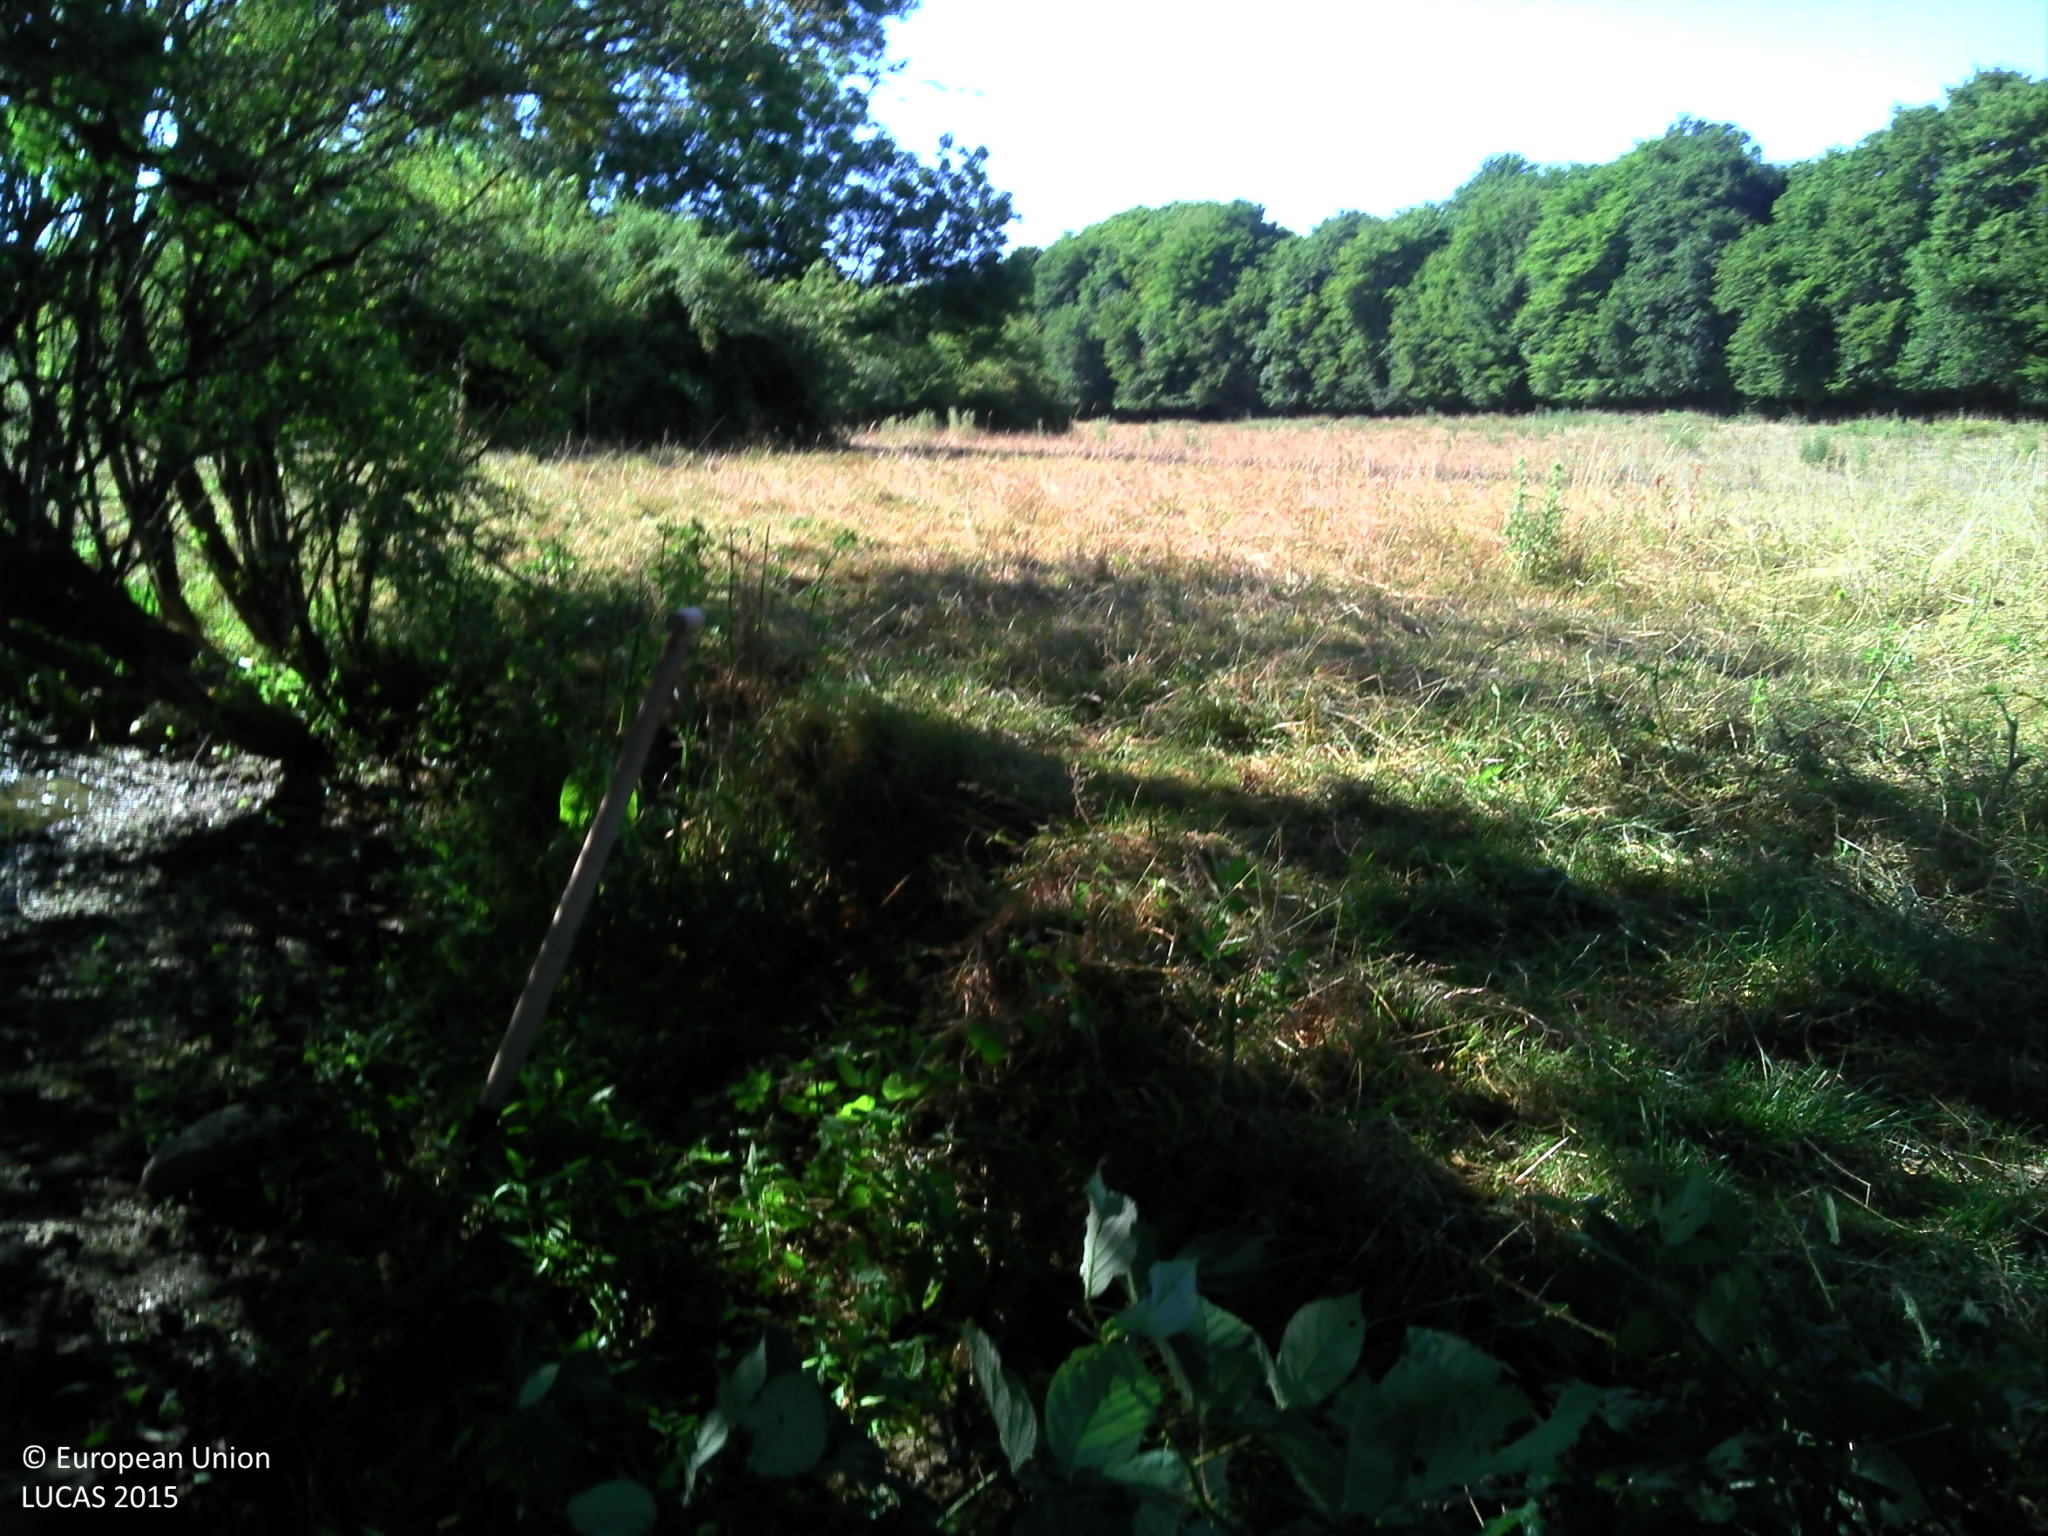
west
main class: Grassland
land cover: Grassland without tree/shrub cover
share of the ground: > 75 %
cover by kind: herbaceous plants 100 %
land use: Agriculture (excluding fallow land and kitchen gardens)
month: July
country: FR
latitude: 46.9900
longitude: 3.5944
